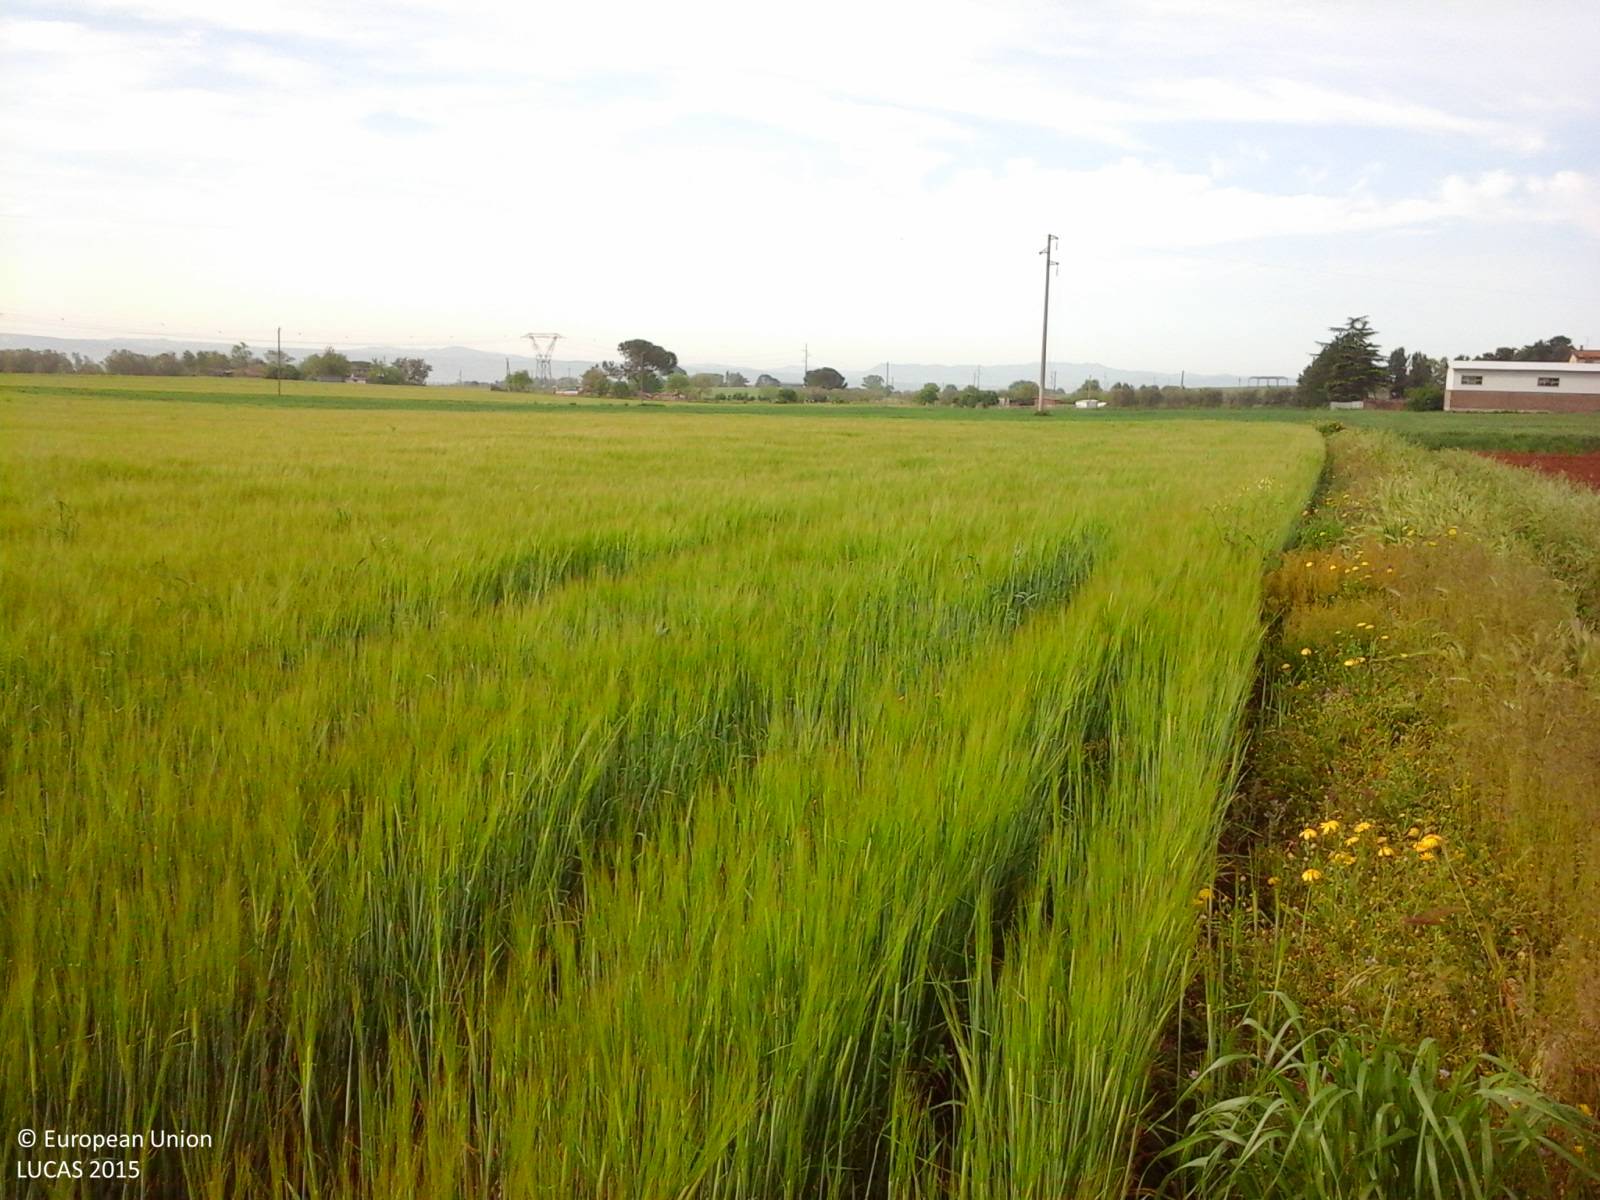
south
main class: Cropland
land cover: Durum wheat
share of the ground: > 75 %
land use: Agriculture (excluding fallow land and kitchen gardens)
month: May
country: IT
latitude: 42.4526
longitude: 12.0480
